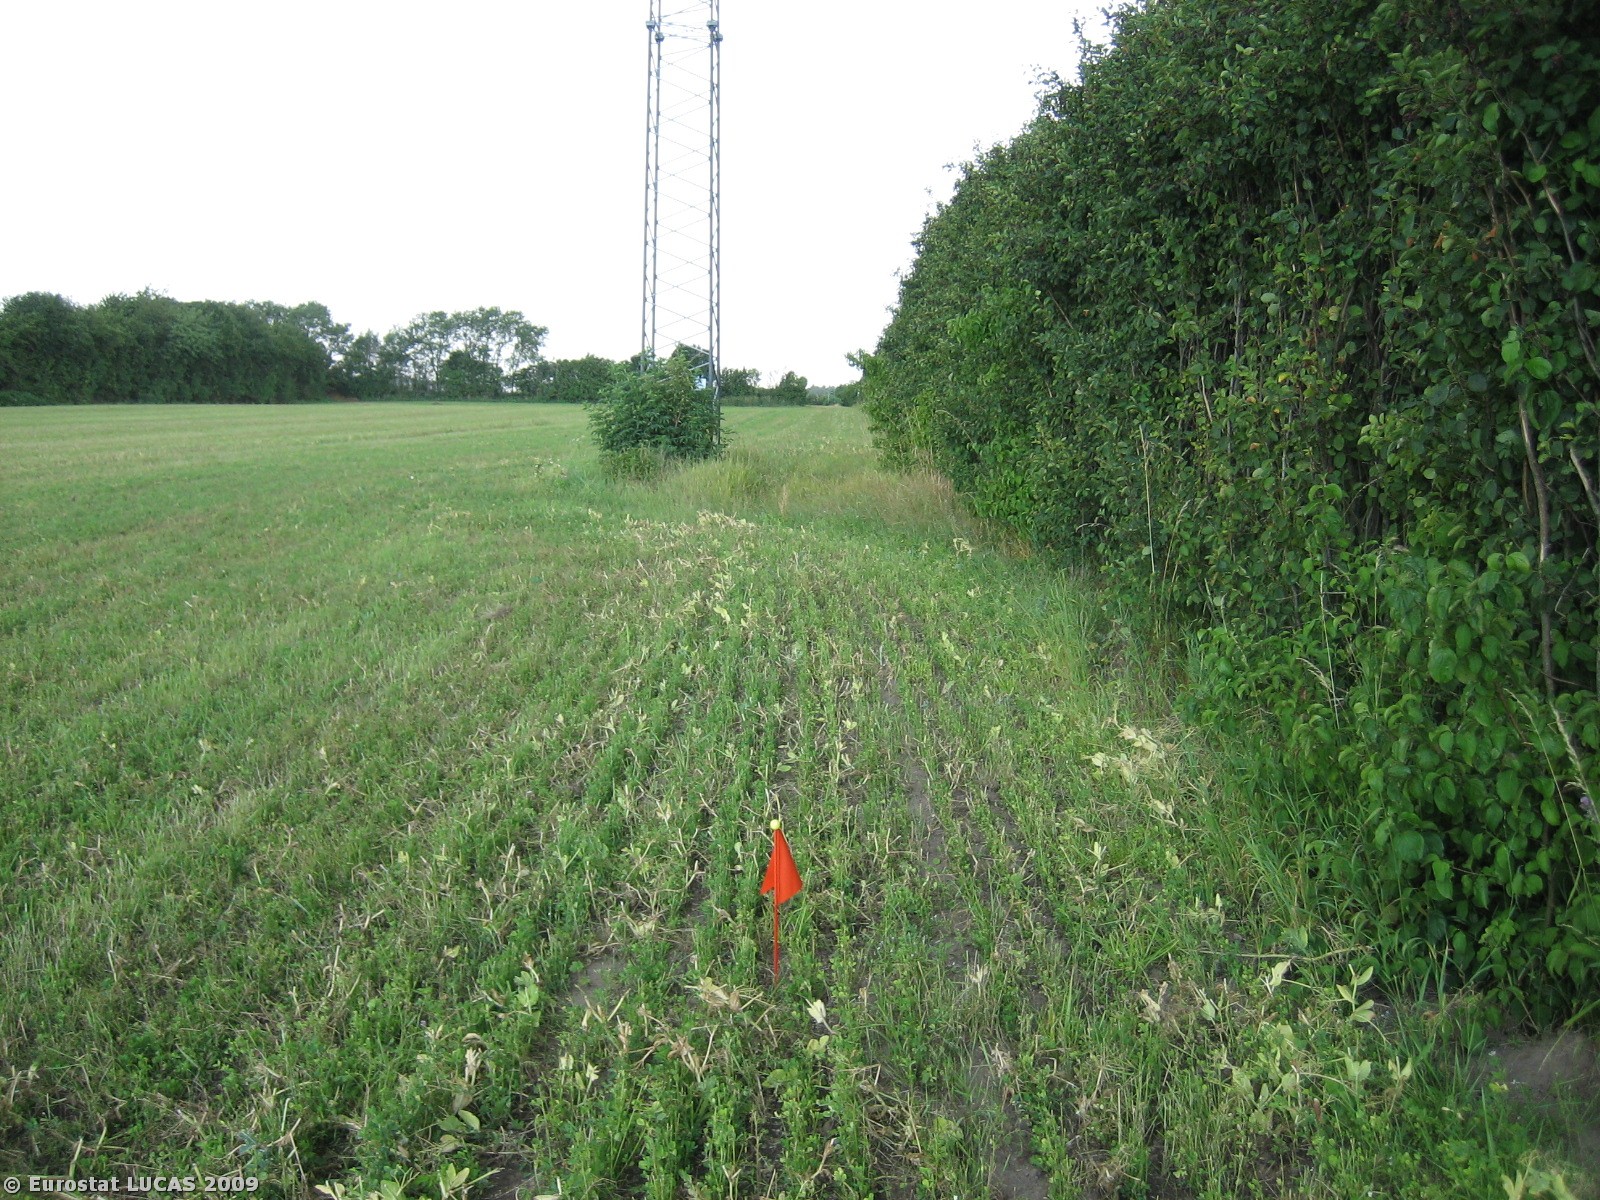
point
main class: Cropland
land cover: Dry pulses
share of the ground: 10 - 25 %
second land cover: Clovers
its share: 50 - 75 %
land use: Agriculture (excluding fallow land and kitchen gardens)
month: July
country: DK
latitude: 55.5403
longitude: 9.6992
